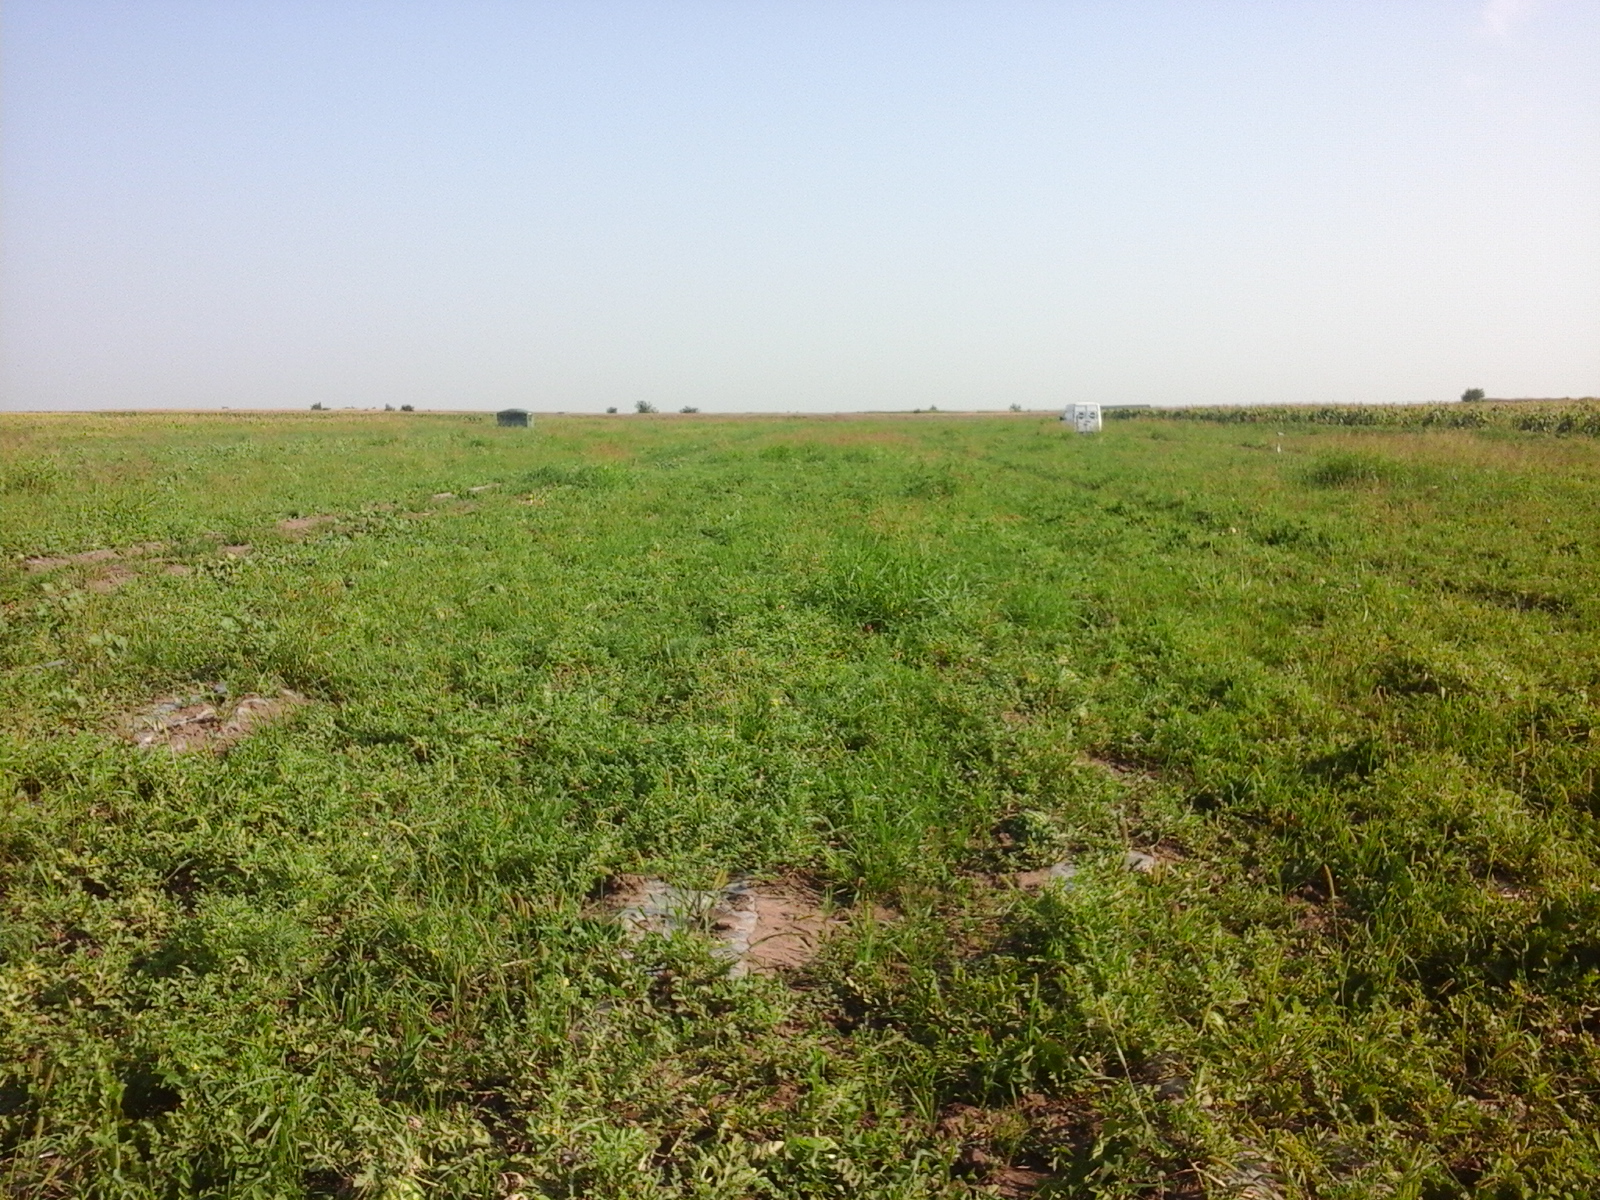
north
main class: Cropland
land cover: Other fresh vegetables
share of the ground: > 75 %
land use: Agriculture (excluding fallow land and kitchen gardens)
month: August
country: RO
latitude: 45.8382
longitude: 27.5790
